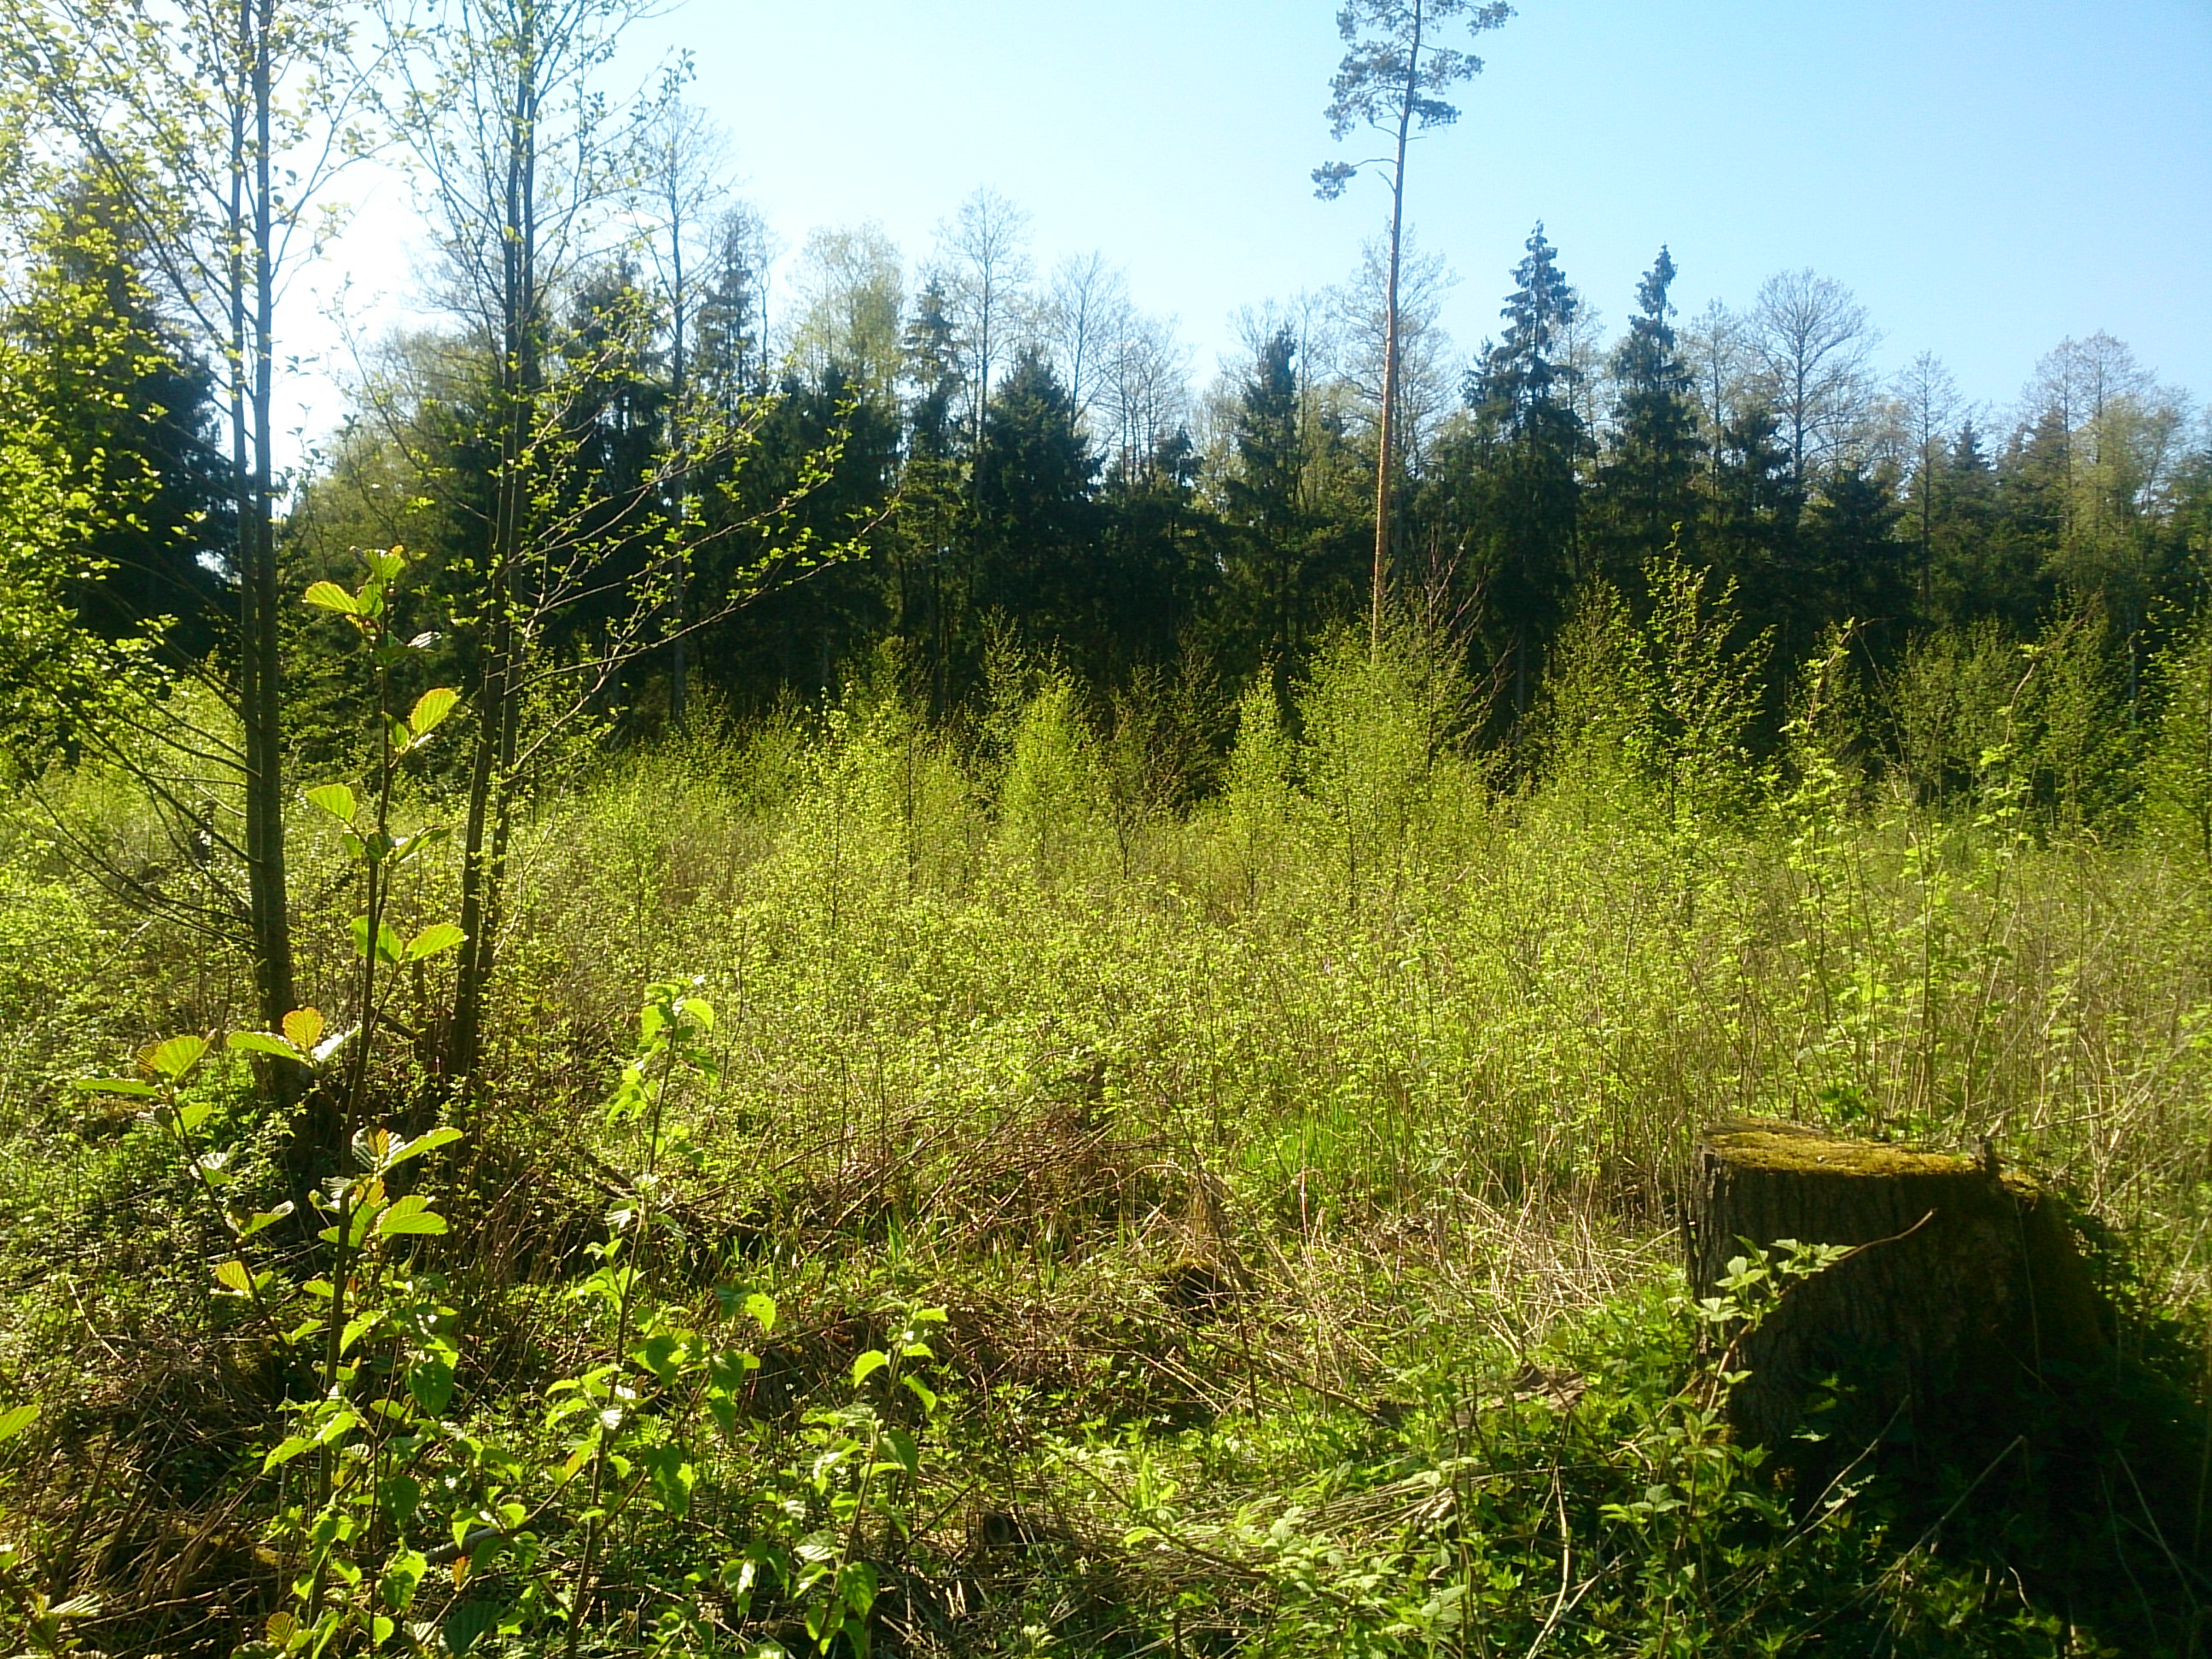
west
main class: Woodland
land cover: Broadleaved woodland
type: non-riverine alder, birch or aspen forest
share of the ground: > 75 %
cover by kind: broadleaved forest trees 50 %, shrubs 50 %
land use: Forestry
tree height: < 5 m
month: May
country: LV
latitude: 56.7388
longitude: 24.4308
